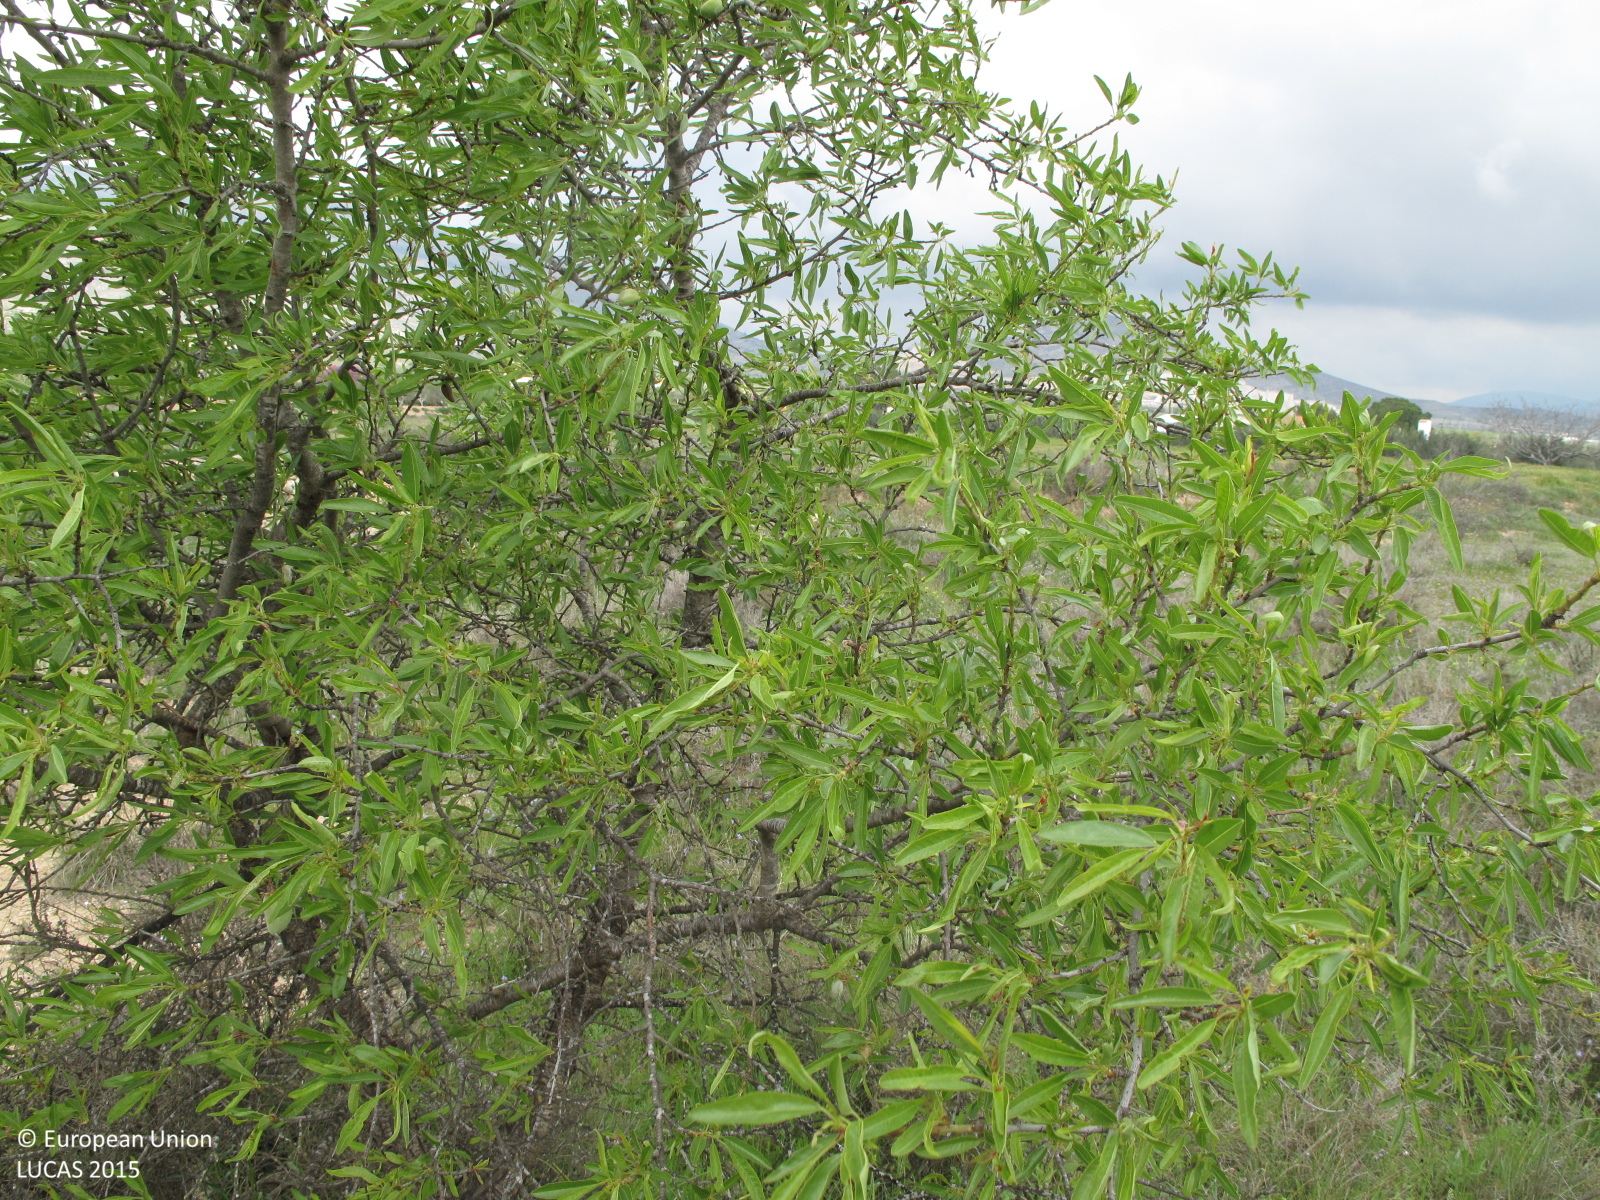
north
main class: Shrubland
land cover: Shrubland with sparse tree cover
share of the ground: 25 - 50 %
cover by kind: herbaceous plants 50 %, shrubs 40 %, broadleaved forest trees 5 %, consolidated bare surface 5 %
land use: Abandoned areas
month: April
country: ES
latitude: 38.7160
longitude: -0.9982
